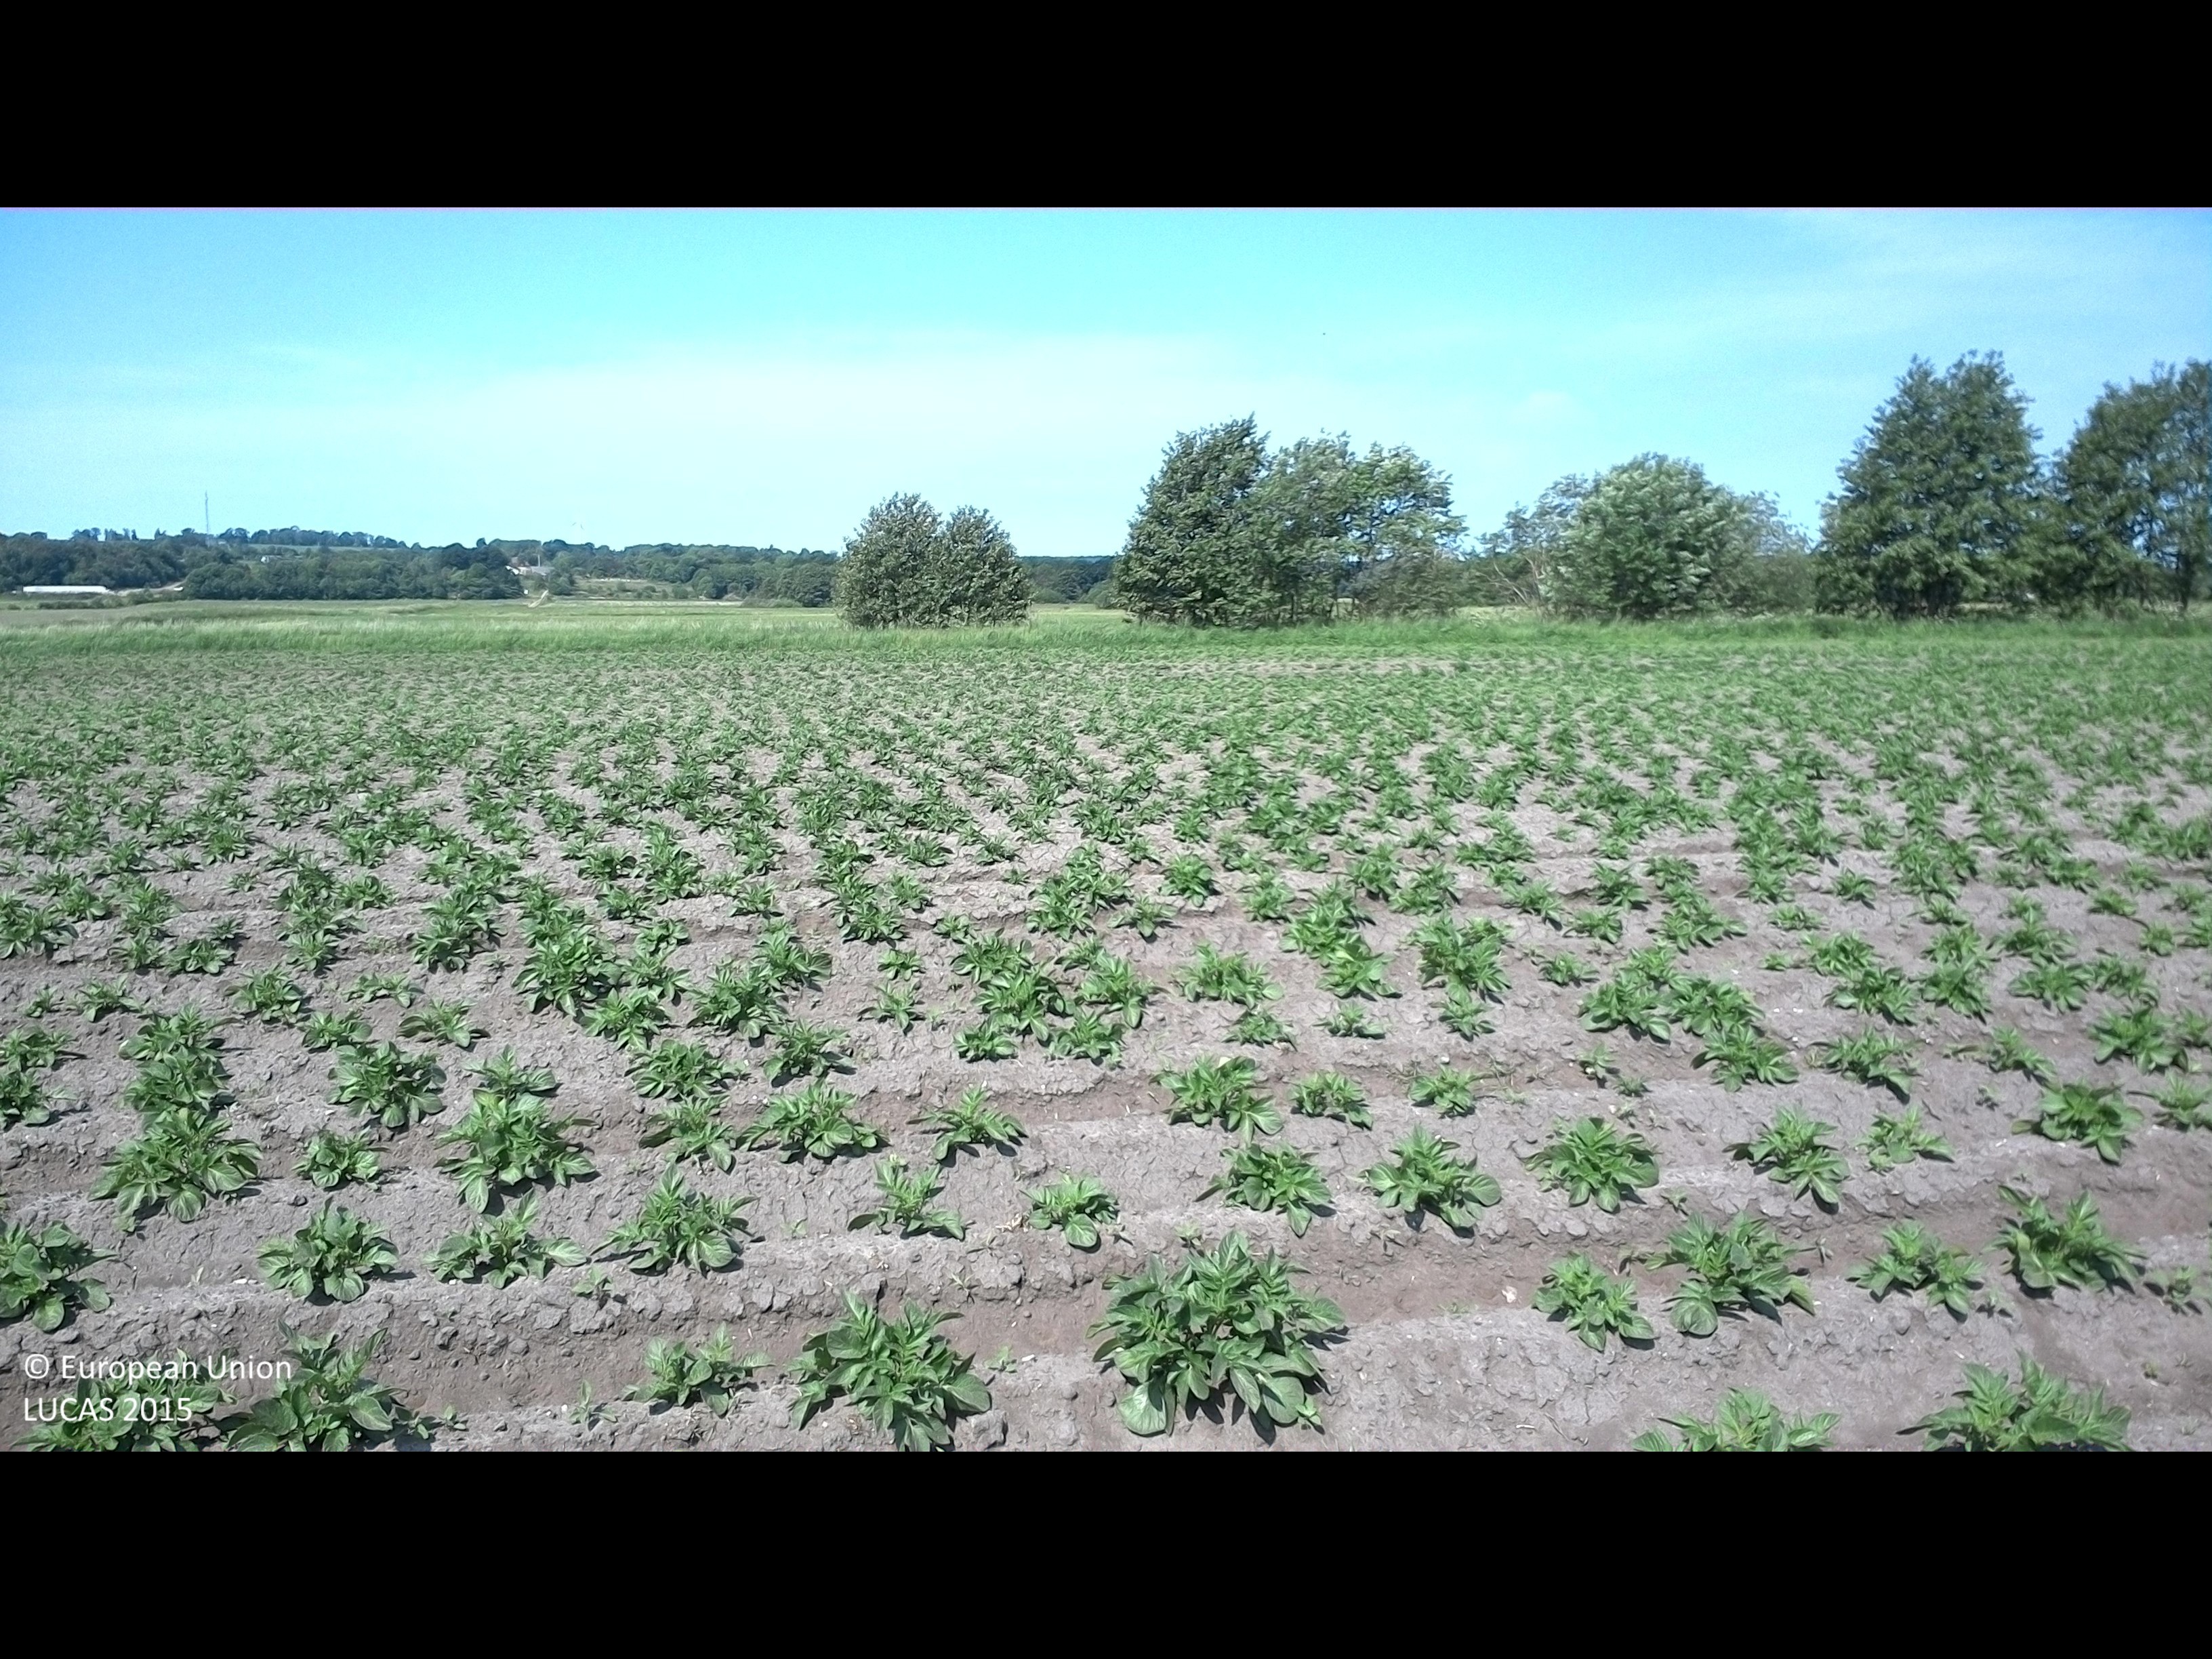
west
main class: Cropland
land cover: Potatoes
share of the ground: 50 - 75 %
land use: Agriculture (excluding fallow land and kitchen gardens)
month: June
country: SE
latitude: 55.7953
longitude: 14.1933
